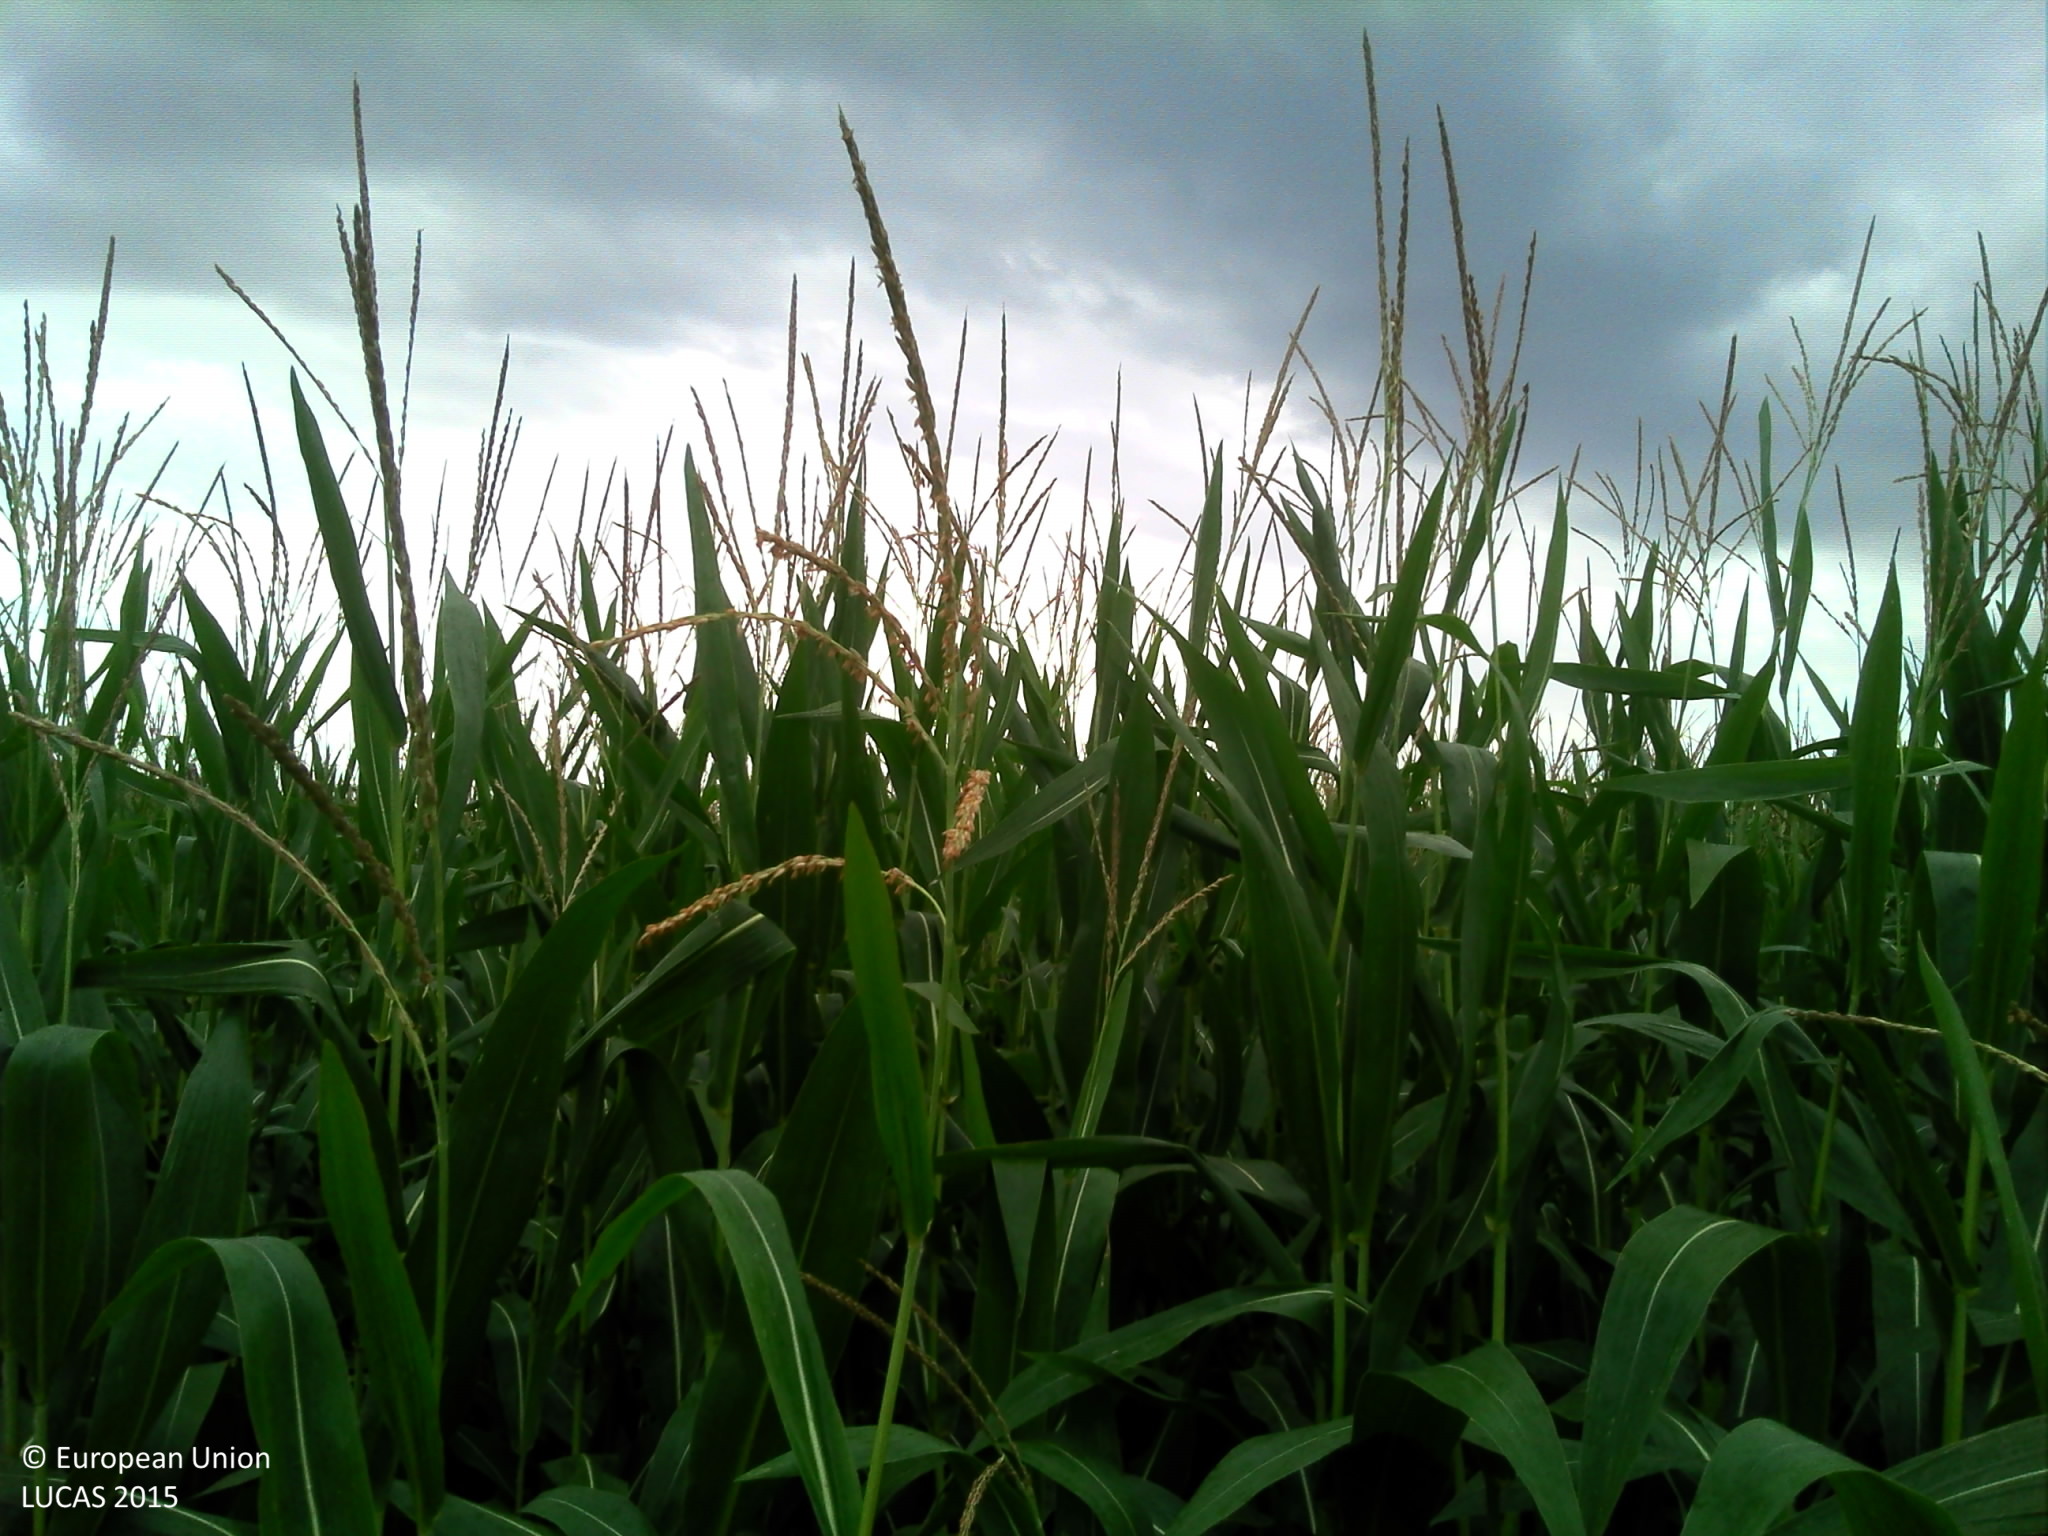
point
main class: Cropland
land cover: Maize
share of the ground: > 75 %
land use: Agriculture (excluding fallow land and kitchen gardens)
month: July
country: FR
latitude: 48.9020
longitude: 7.7224
